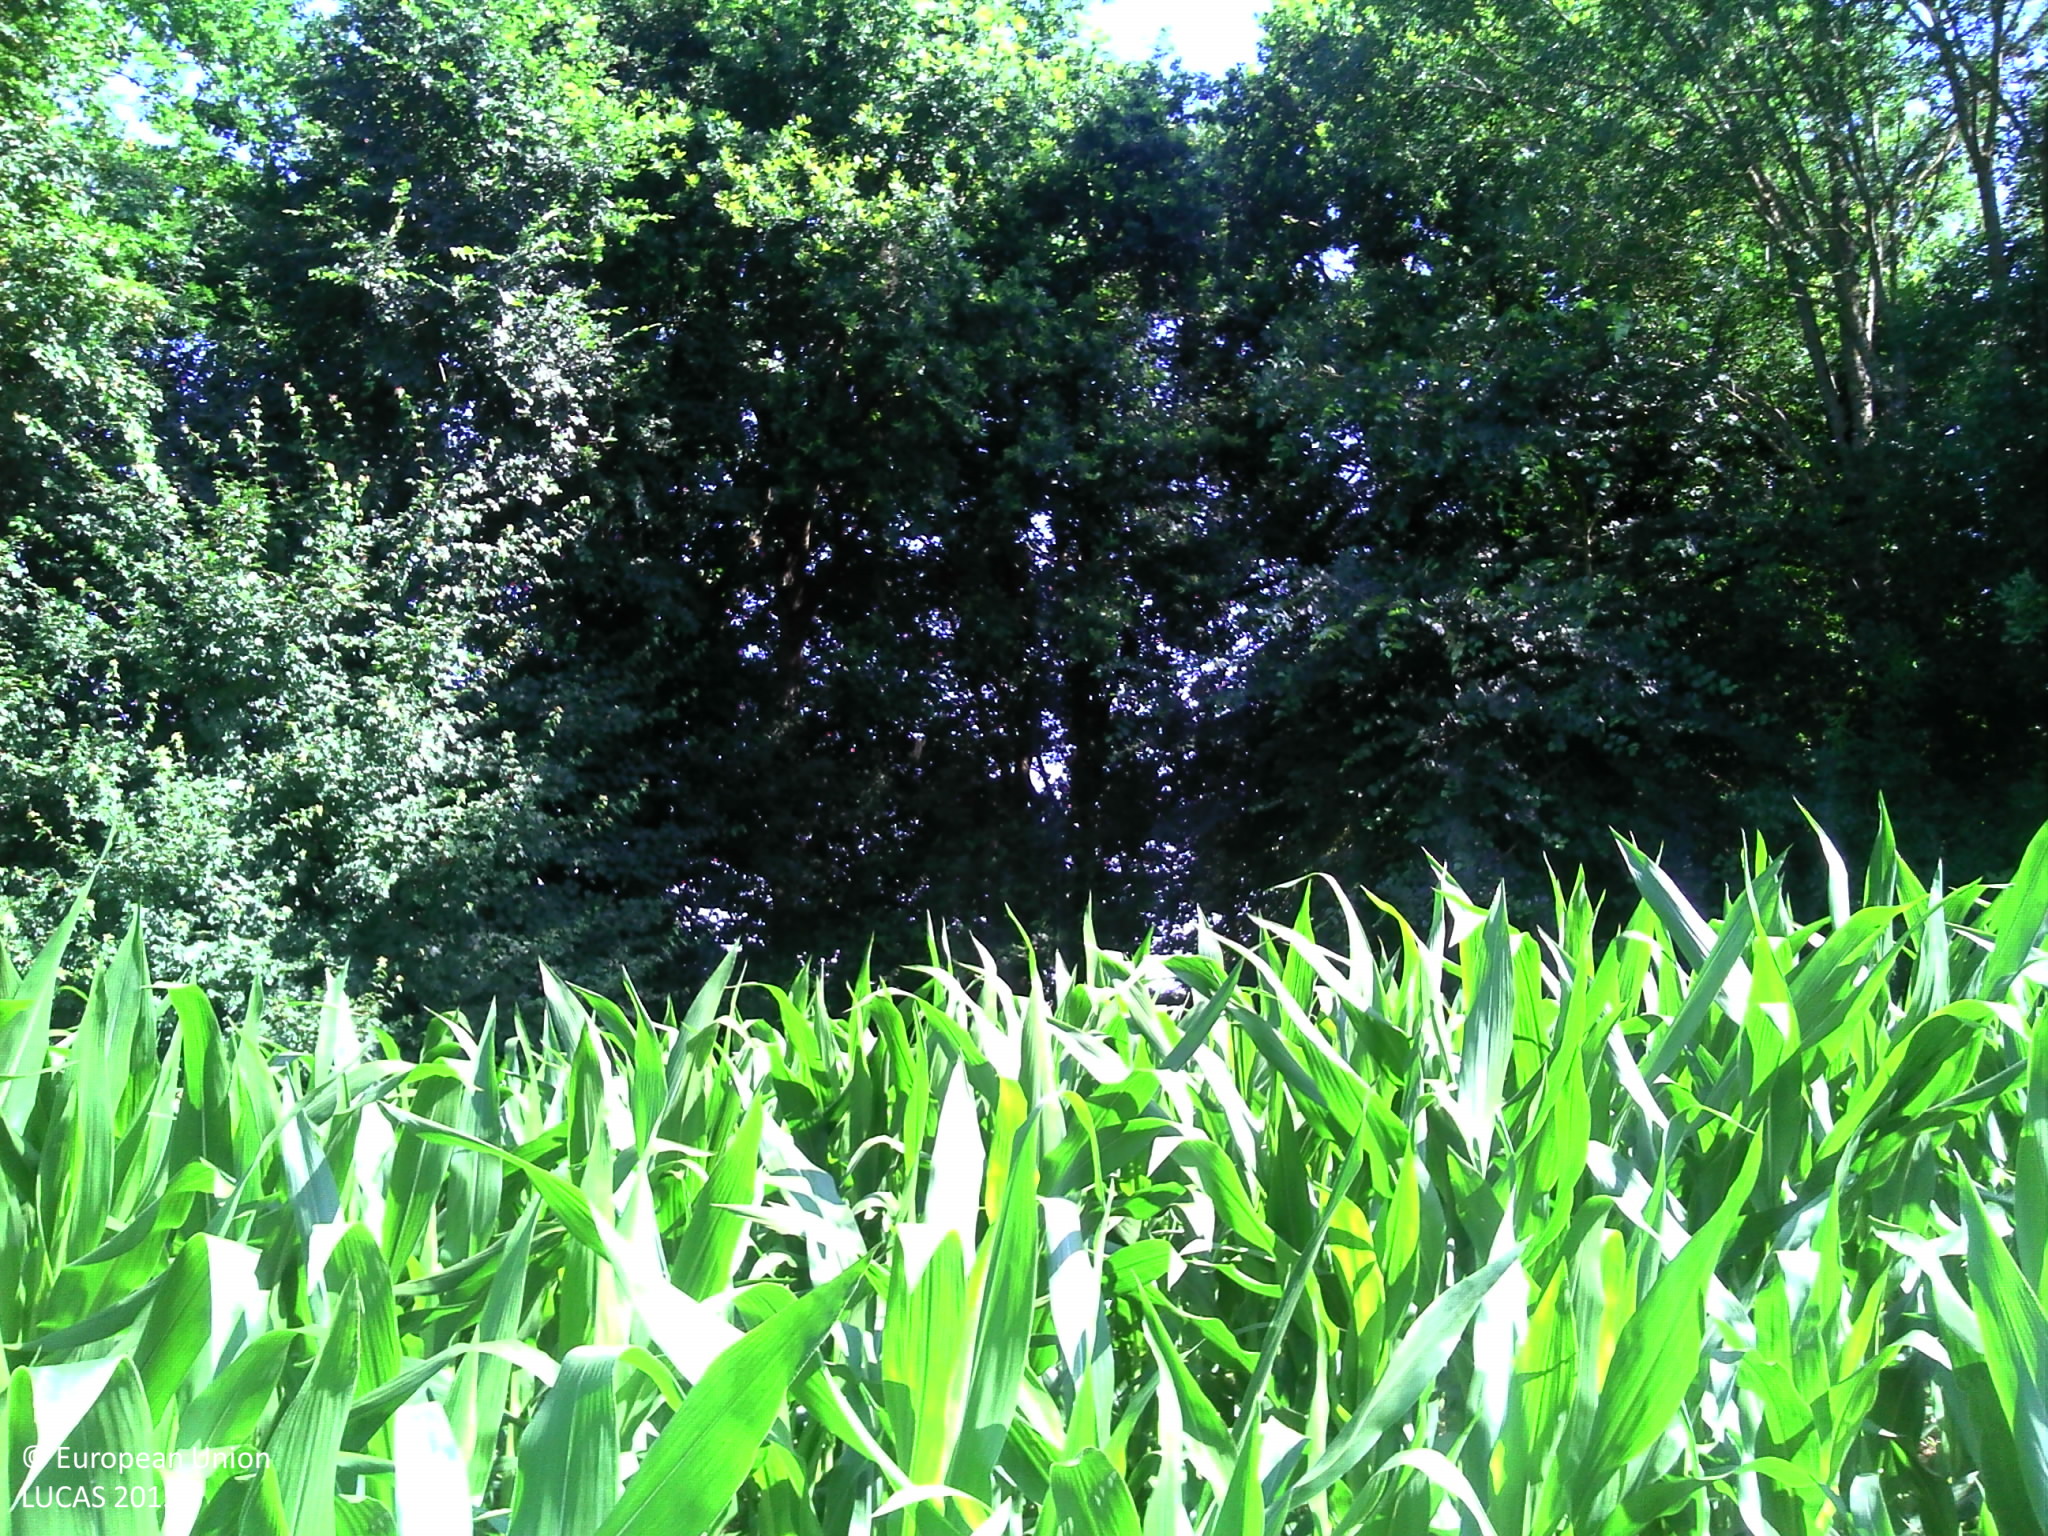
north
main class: Cropland
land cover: Maize
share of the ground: > 75 %
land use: Agriculture (excluding fallow land and kitchen gardens)
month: June
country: FR
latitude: 45.7906
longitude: -0.7412
